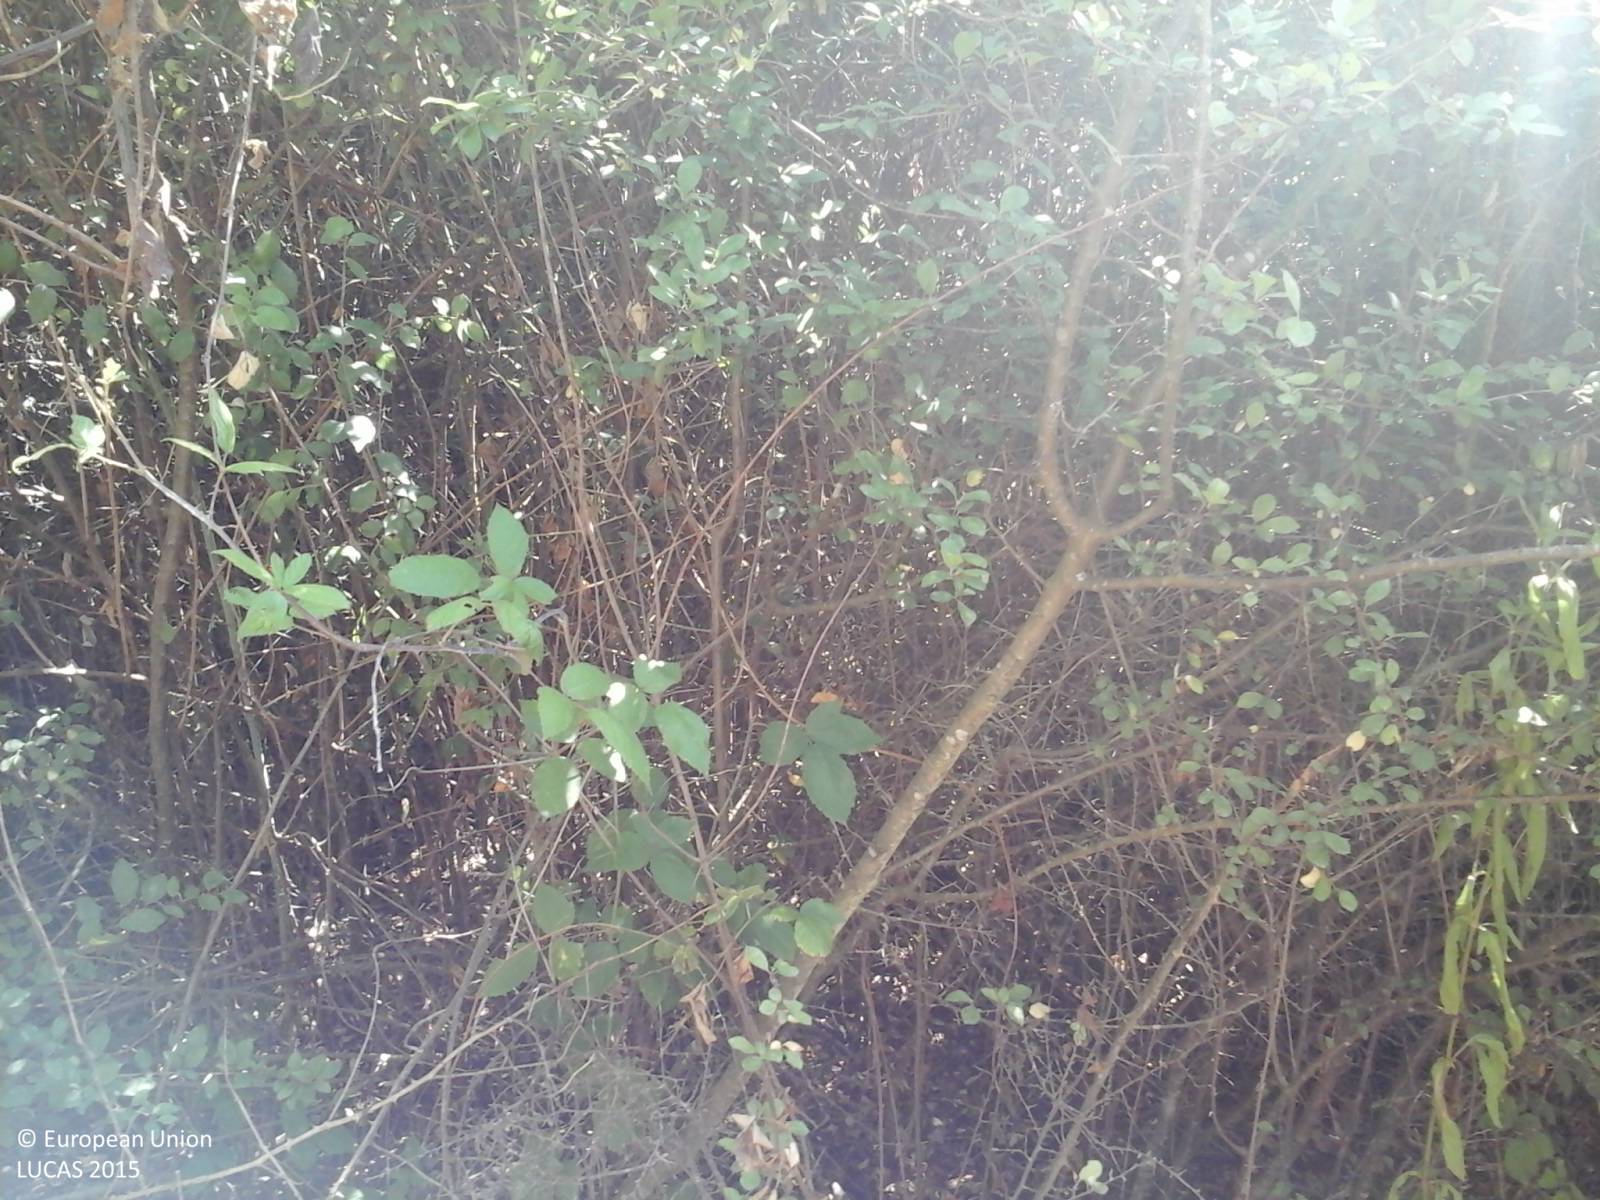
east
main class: Cropland
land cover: Nuts trees
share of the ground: > 75 %
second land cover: Spontaneously vegetated surfaces
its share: 10 - 25 %
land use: Agriculture (excluding fallow land and kitchen gardens)
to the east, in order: Nuts trees; Spontaneously vegetated surfaces; Broadleaved woodland; Fences; Grassland without tree/shrub cover; Fences; Nuts trees; Fences; Grassland without tree/shrub cover; Electric lines; Paved roads, cycling and walking lanes; Electric lines; Fences; Olive groves
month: July
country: IT
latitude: 42.1919
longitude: 12.4012
